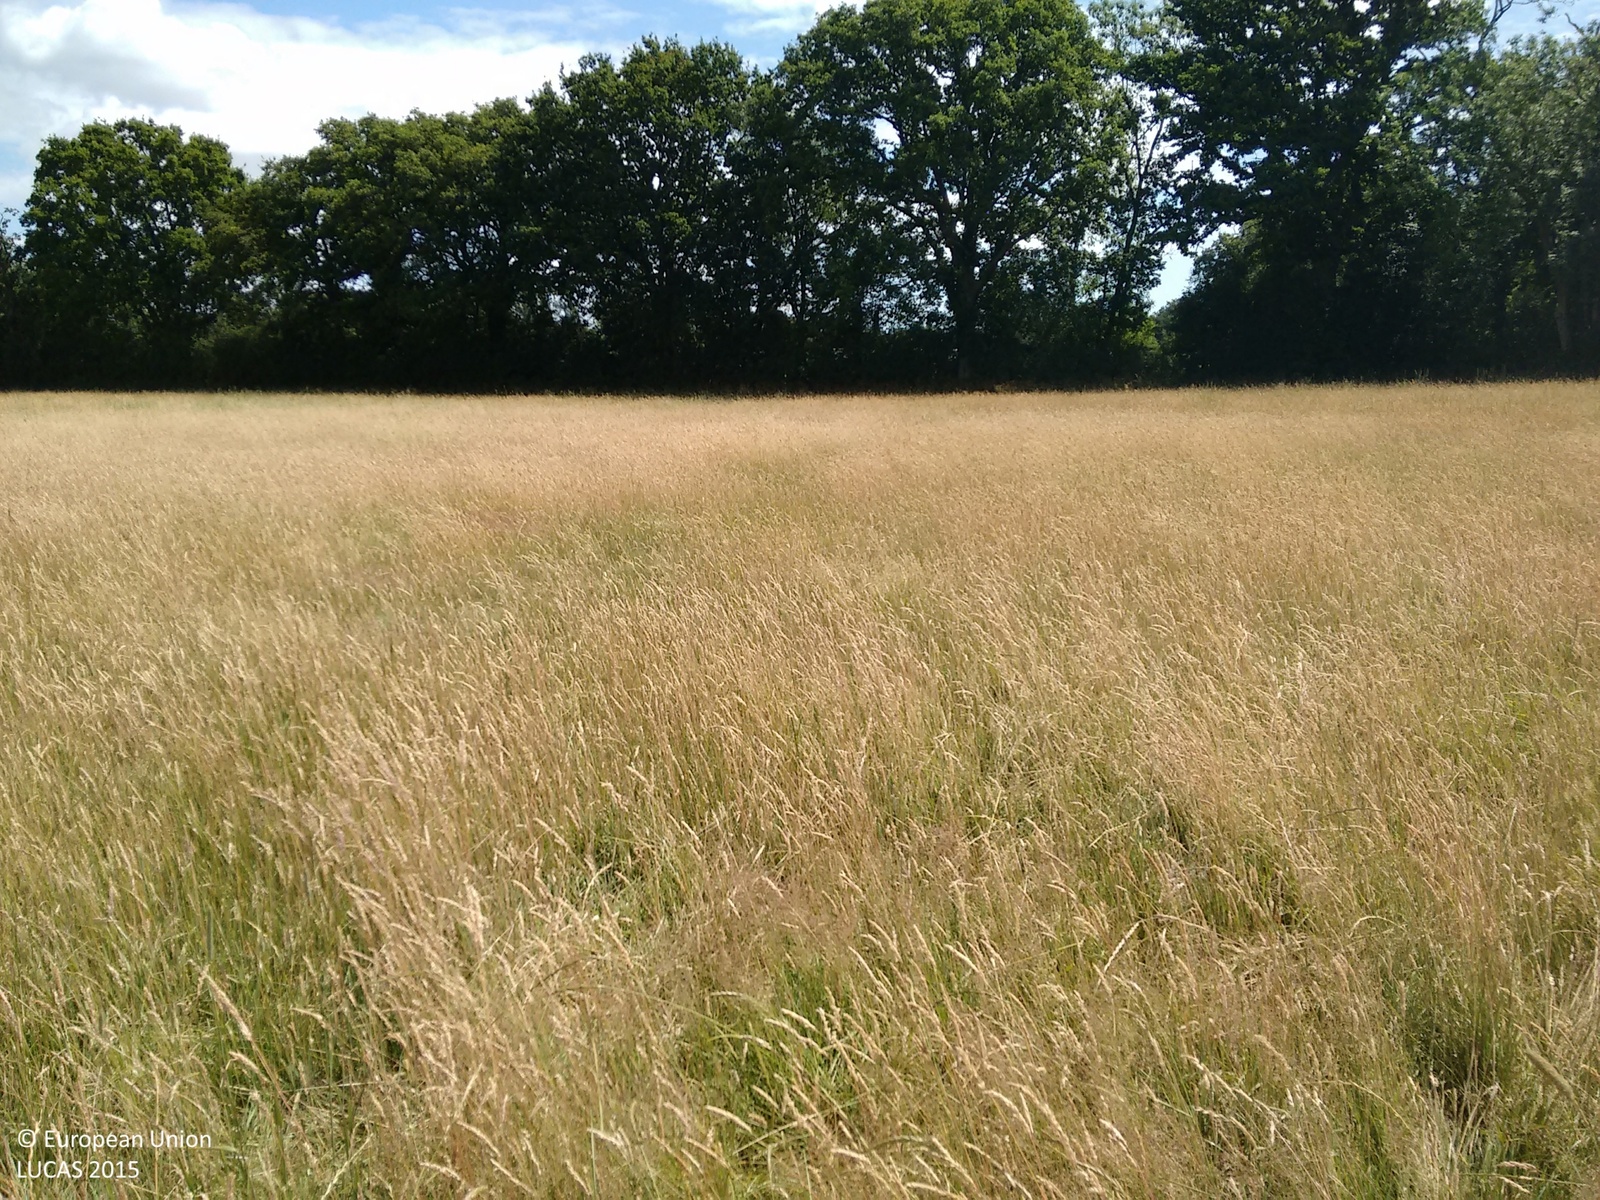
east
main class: Grassland
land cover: Grassland without tree/shrub cover
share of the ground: > 75 %
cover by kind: herbaceous plants 100 %
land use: Agriculture (excluding fallow land and kitchen gardens)
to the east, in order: Grassland without tree/shrub cover; Broadleaved woodland; Fences; Broadleaved woodland; Grassland without tree/shrub cover; Fences; Grassland without tree/shrub cover; Fences; Grassland without tree/shrub cover; Electric lines; Grassland without tree/shrub cover; Artificial constructions in urban areas; Broadleaved woodland
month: July
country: GB
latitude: 51.0103
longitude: -0.4278
